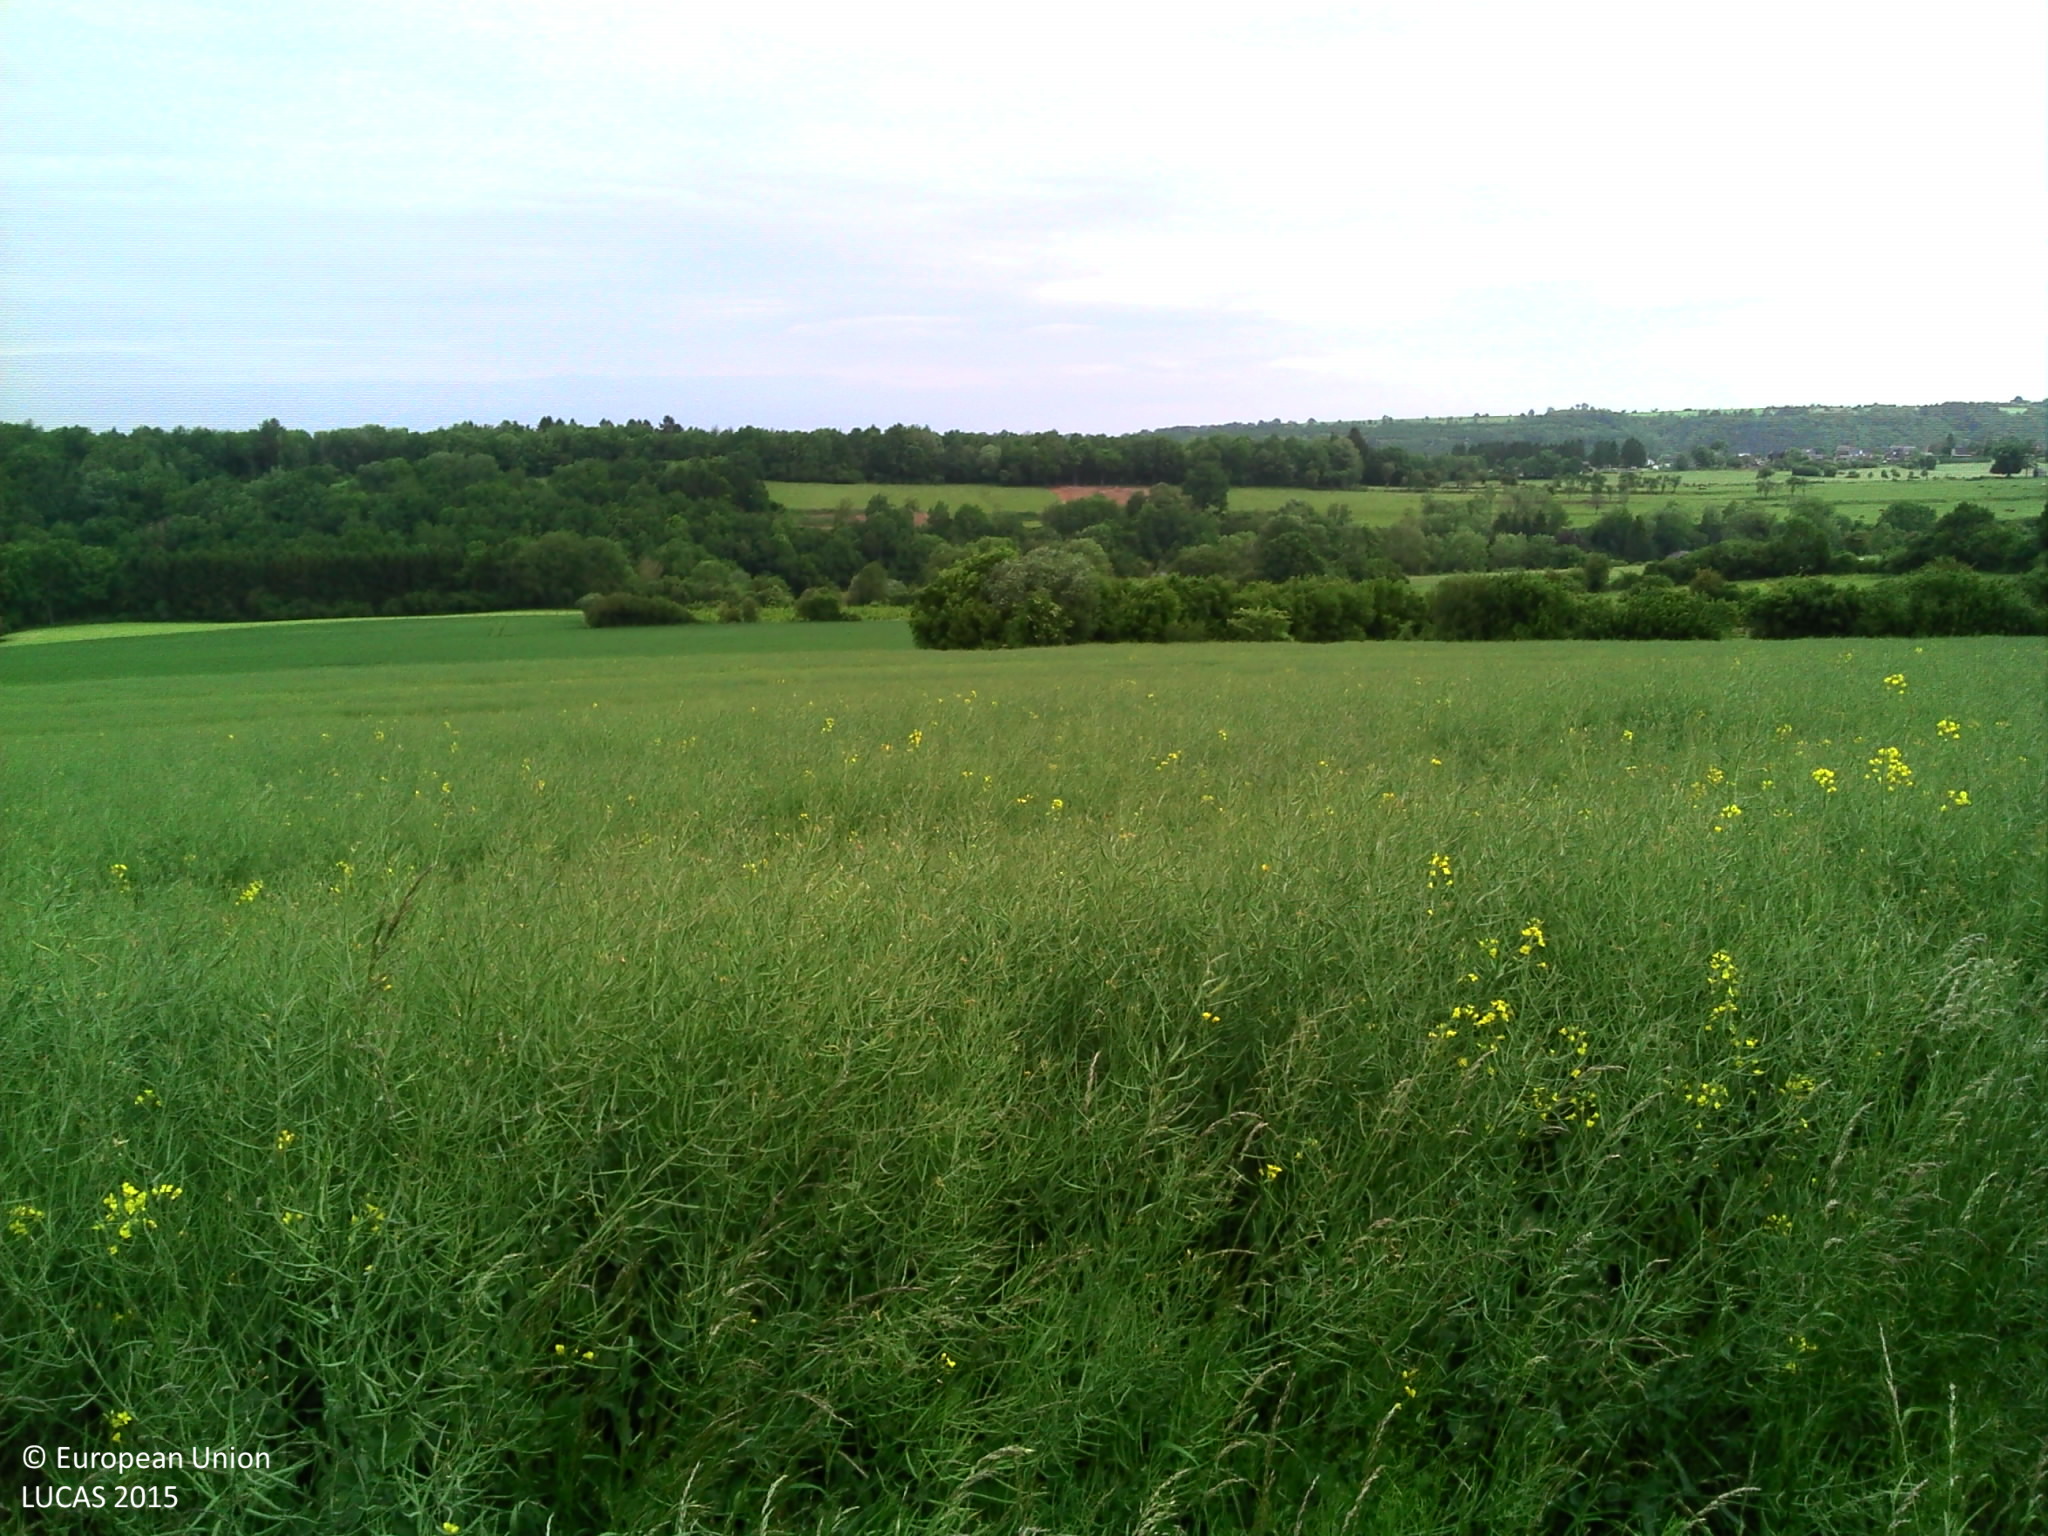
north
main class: Cropland
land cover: Rape and turnip rape
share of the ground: > 75 %
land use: Agriculture (excluding fallow land and kitchen gardens)
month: June
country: BE
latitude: 50.4412
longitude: 5.5911
